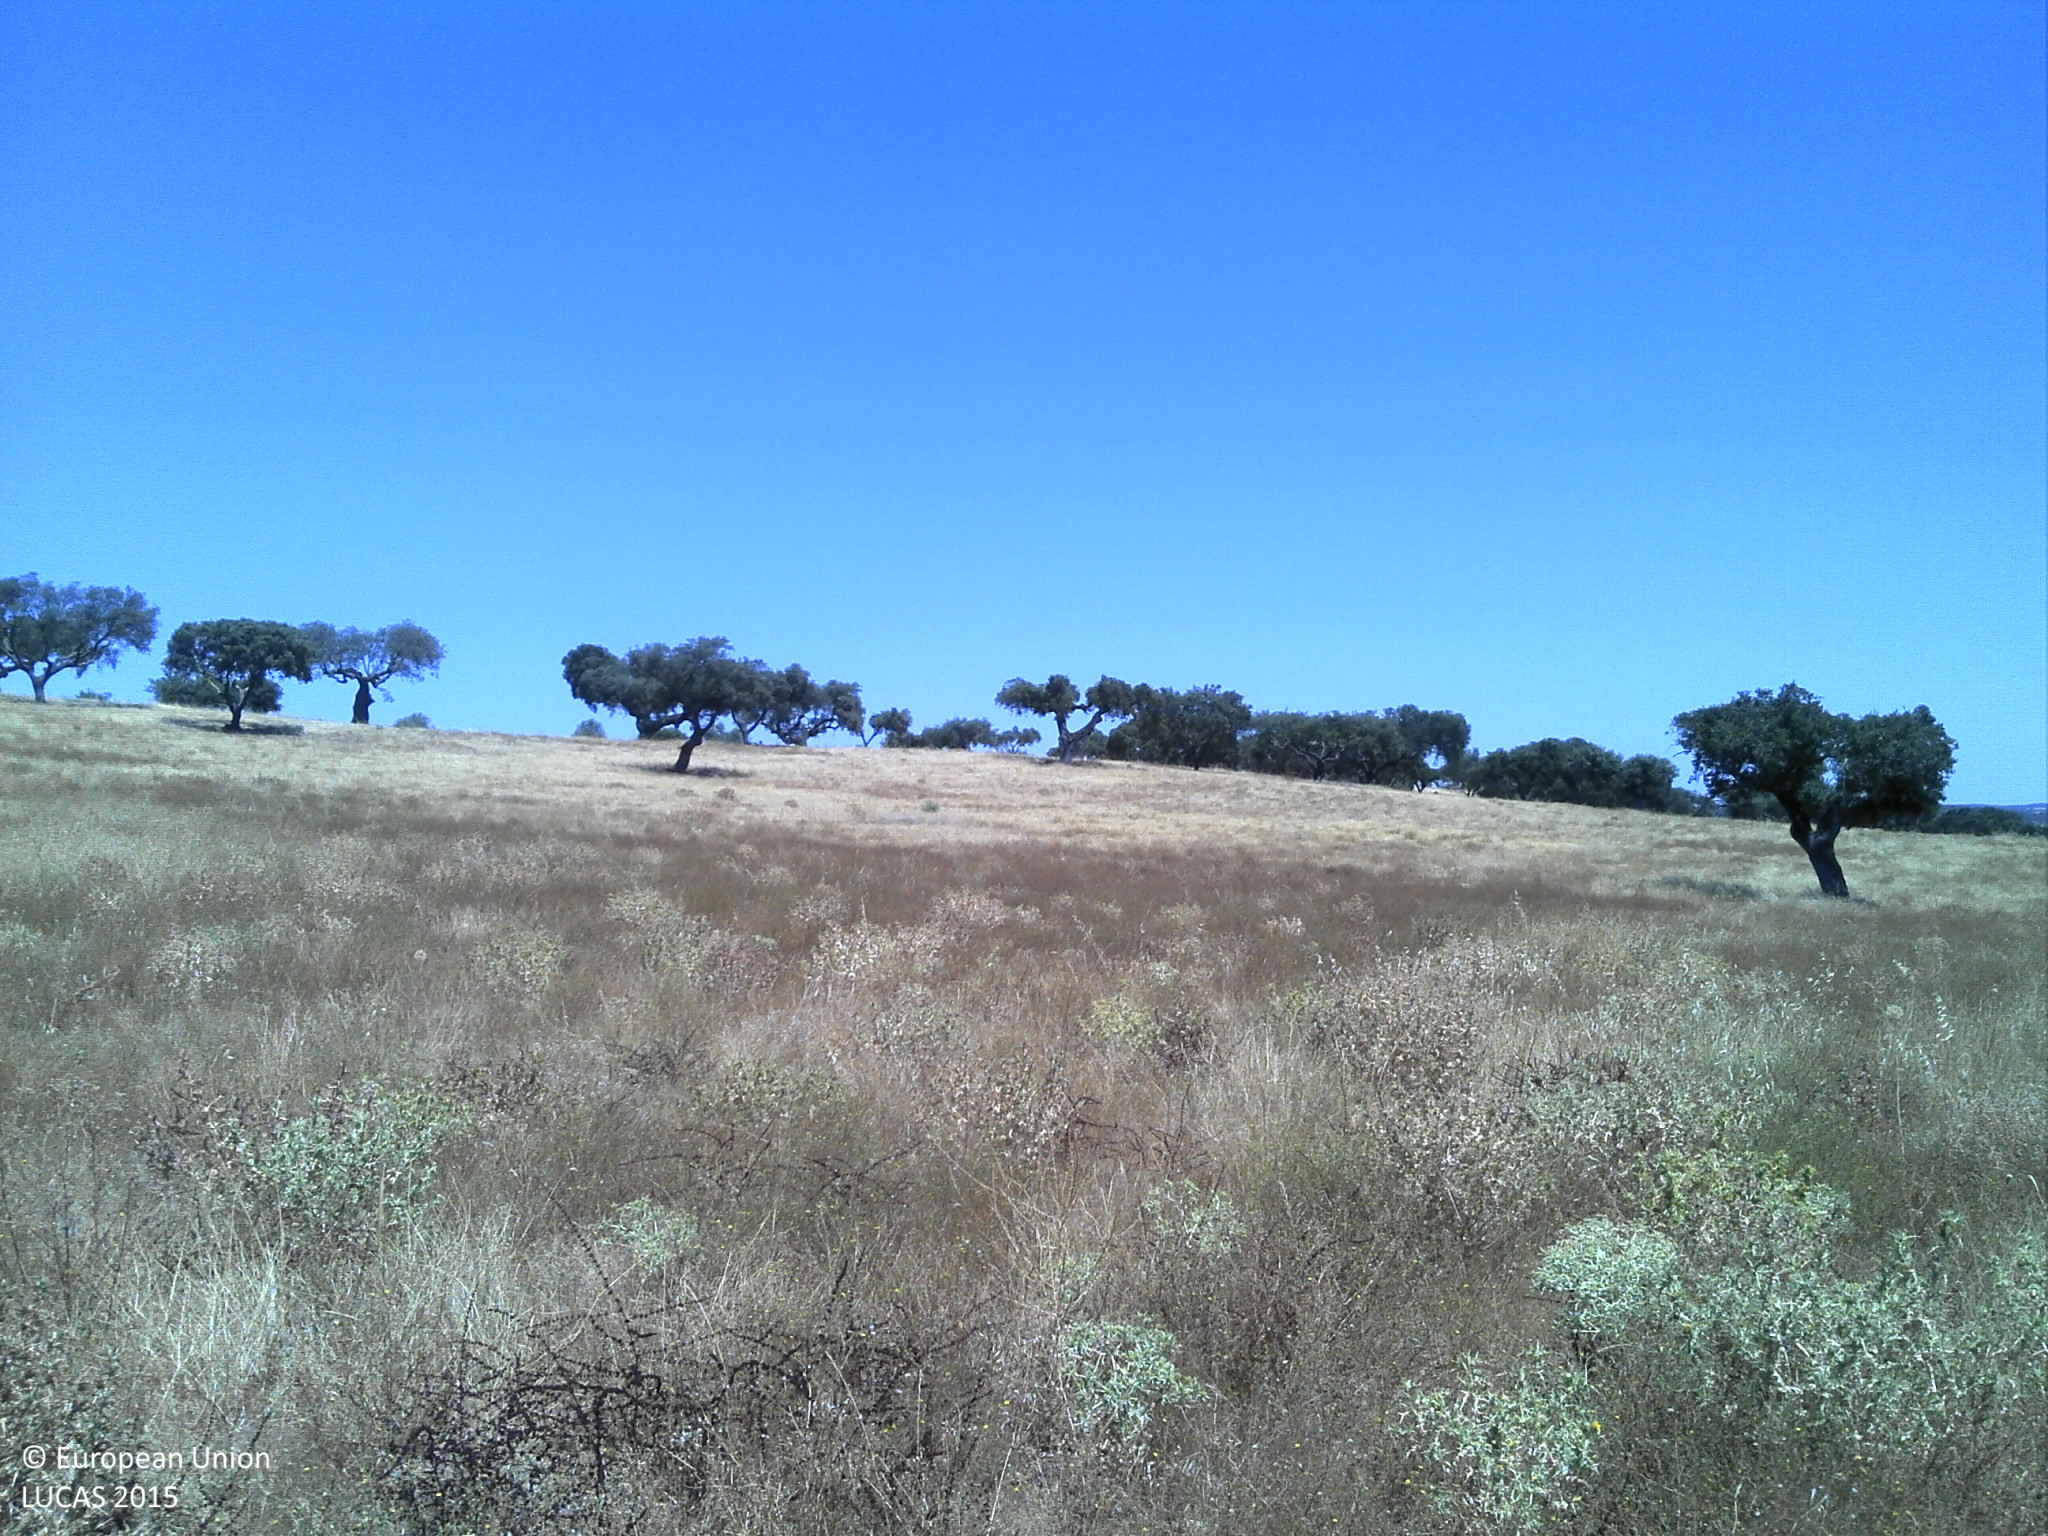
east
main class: Grassland
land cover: Grassland without tree/shrub cover
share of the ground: 25 - 50 %
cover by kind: unconsolidated bare surface 60 %, herbaceous plants 40 %
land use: Agriculture (excluding fallow land and kitchen gardens)
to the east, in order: Grassland without tree/shrub cover; Broadleaved woodland
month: July
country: PT
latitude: 38.5480
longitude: -7.3167
